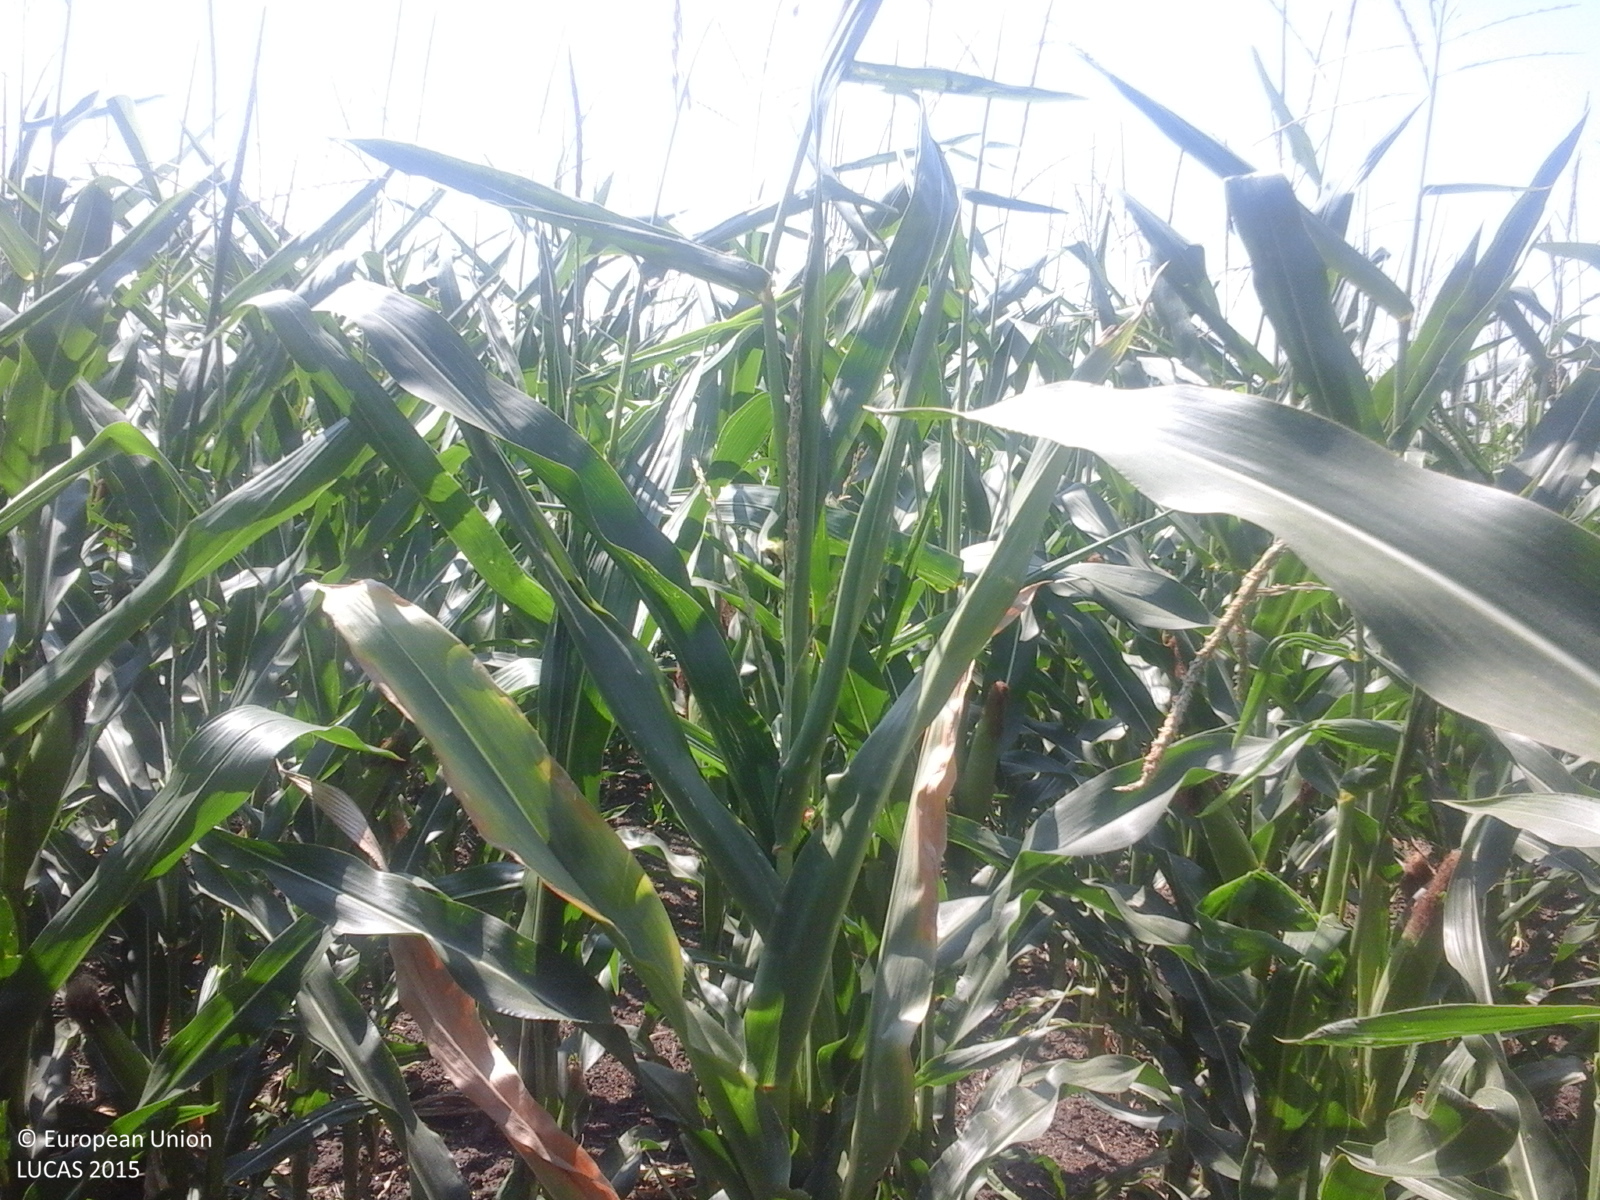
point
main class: Cropland
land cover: Maize
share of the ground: > 75 %
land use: Agriculture (excluding fallow land and kitchen gardens)
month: July
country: RO
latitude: 44.9101
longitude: 27.5130
